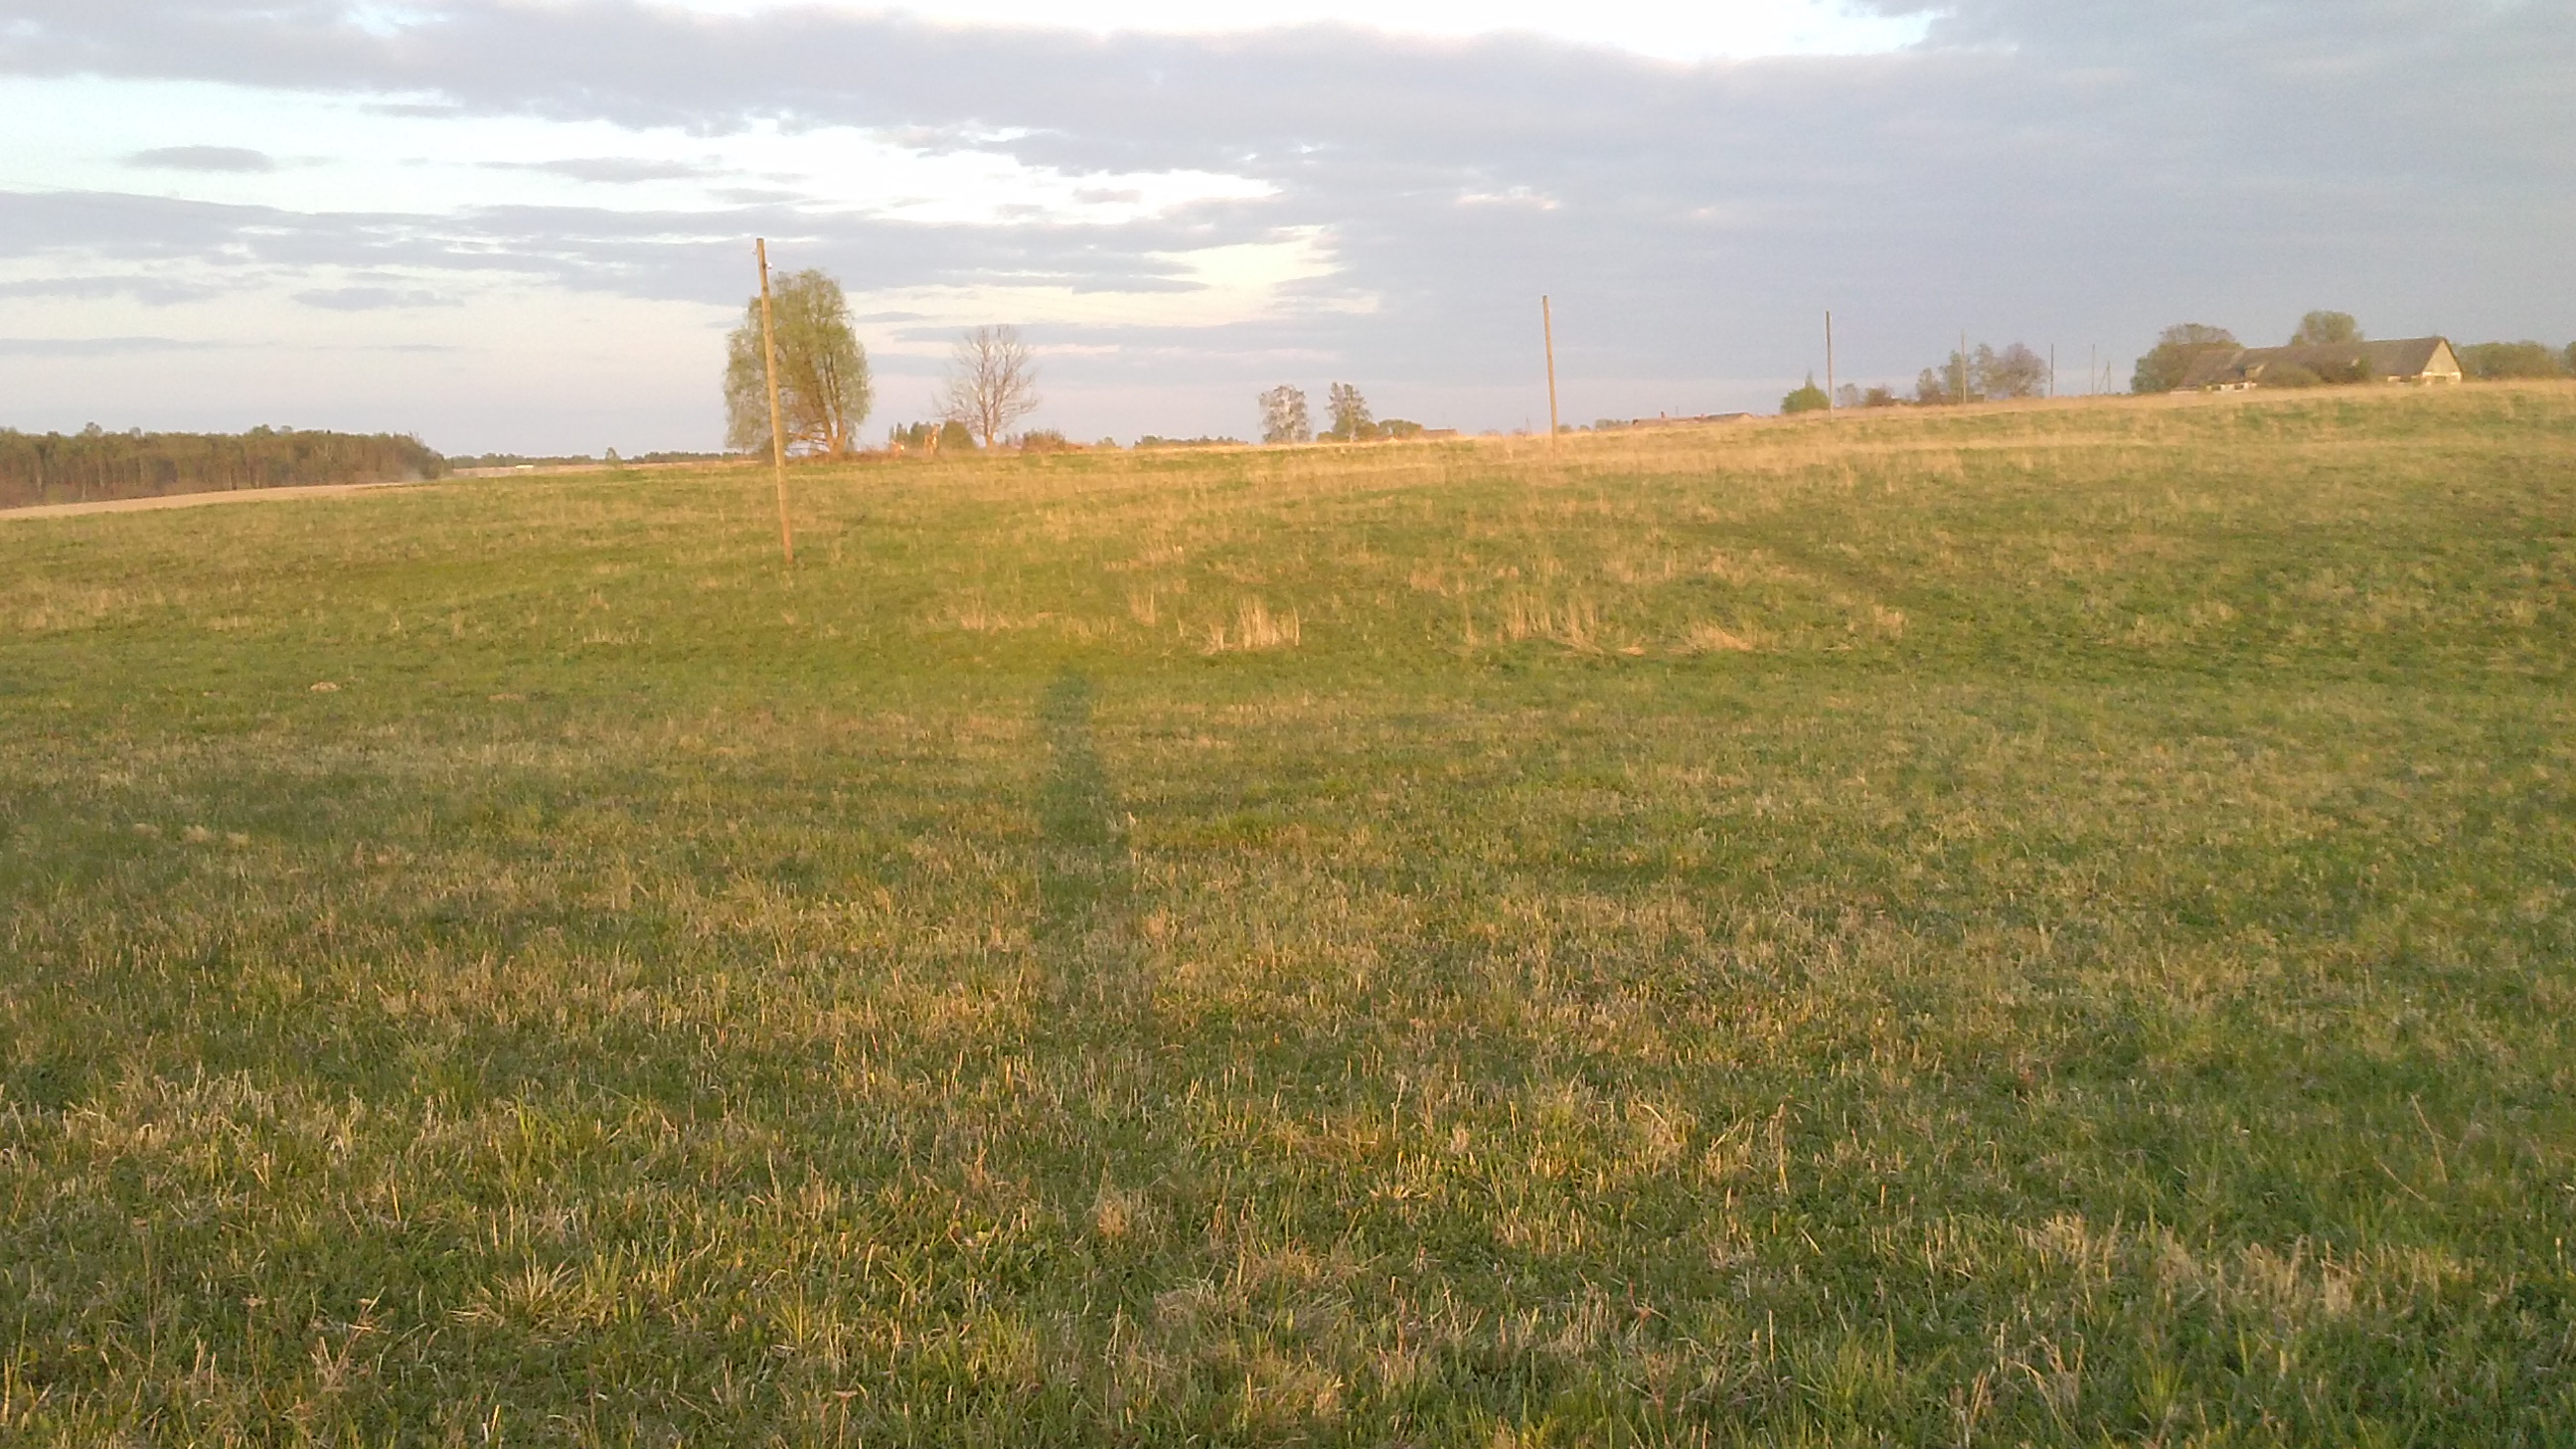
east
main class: Grassland
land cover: Grassland without tree/shrub cover
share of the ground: > 75 %
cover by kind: herbaceous plants 100 %
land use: Agriculture (excluding fallow land and kitchen gardens)
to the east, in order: Grassland without tree/shrub cover; Electric lines; Grassland without tree/shrub cover; Oats; Grass margins; Common wheat
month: May
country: LV
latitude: 55.9279
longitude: 27.5158
